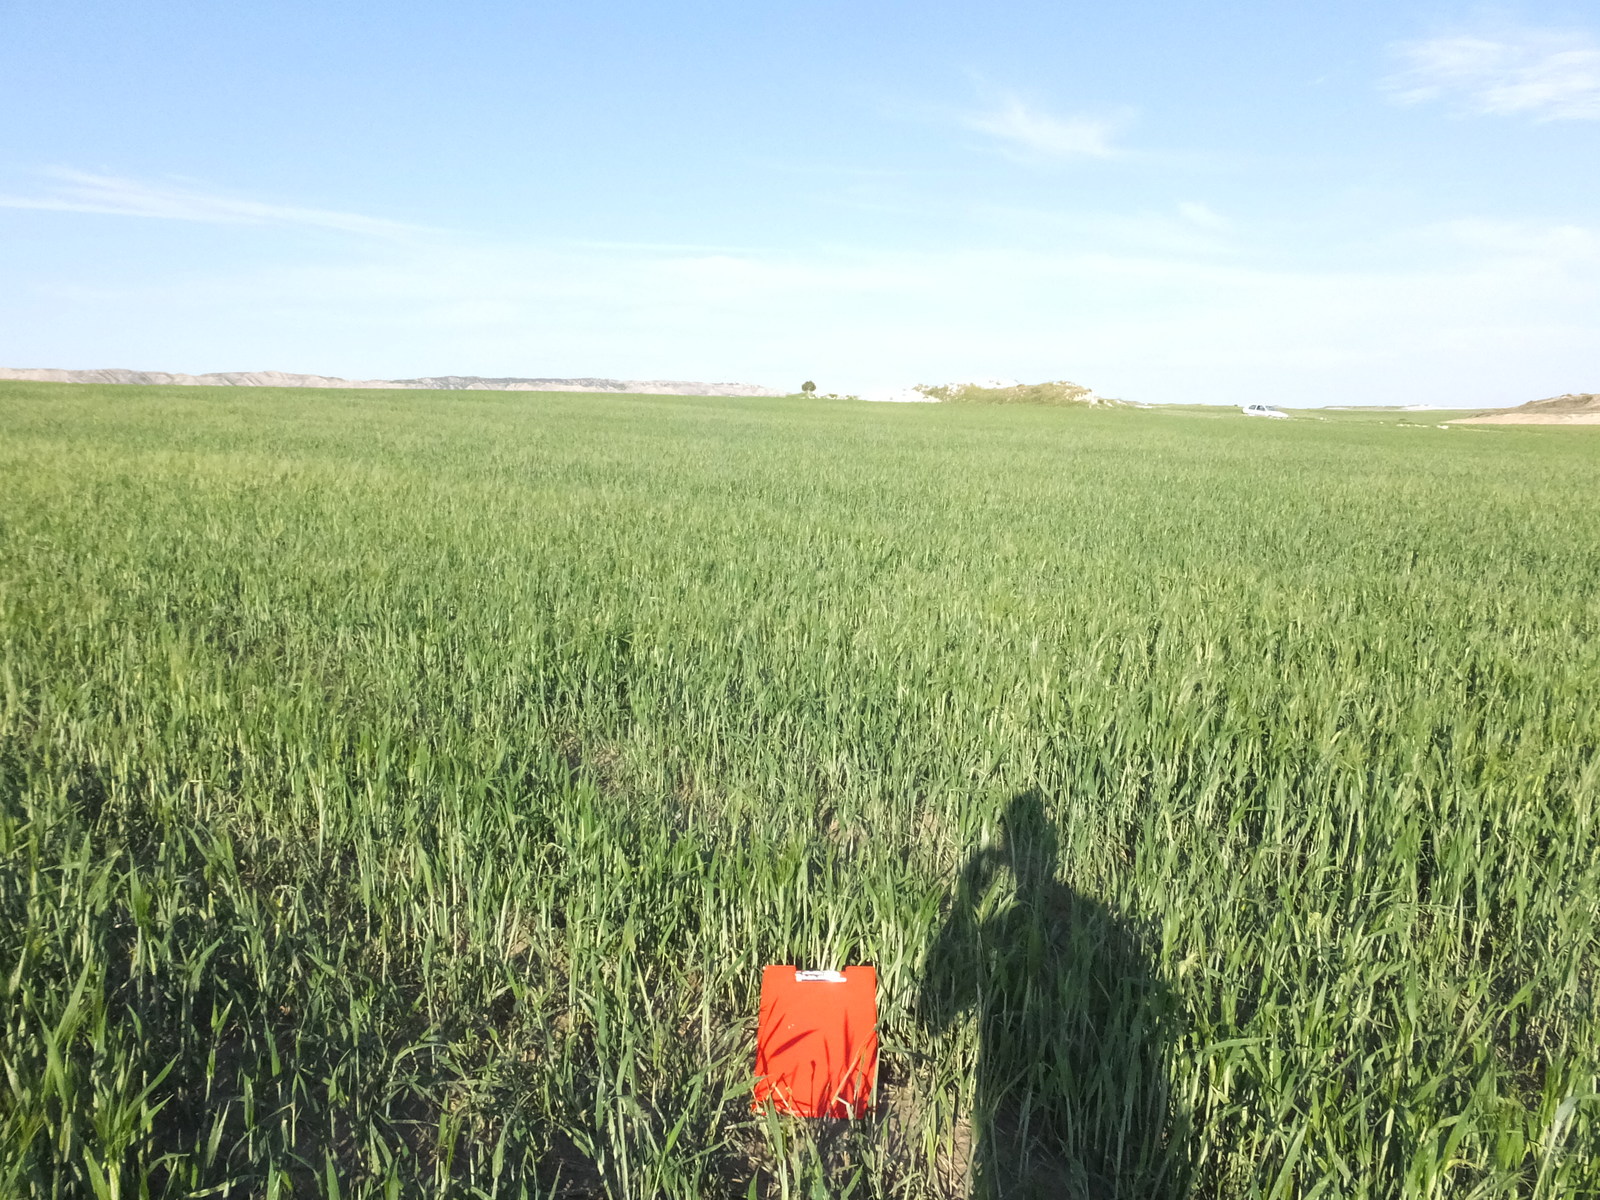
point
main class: Cropland
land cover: Durum wheat
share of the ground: > 75 %
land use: Agriculture (excluding fallow land and kitchen gardens)
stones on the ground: < 10 %
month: April
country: ES
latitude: 41.5462
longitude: -0.2904
